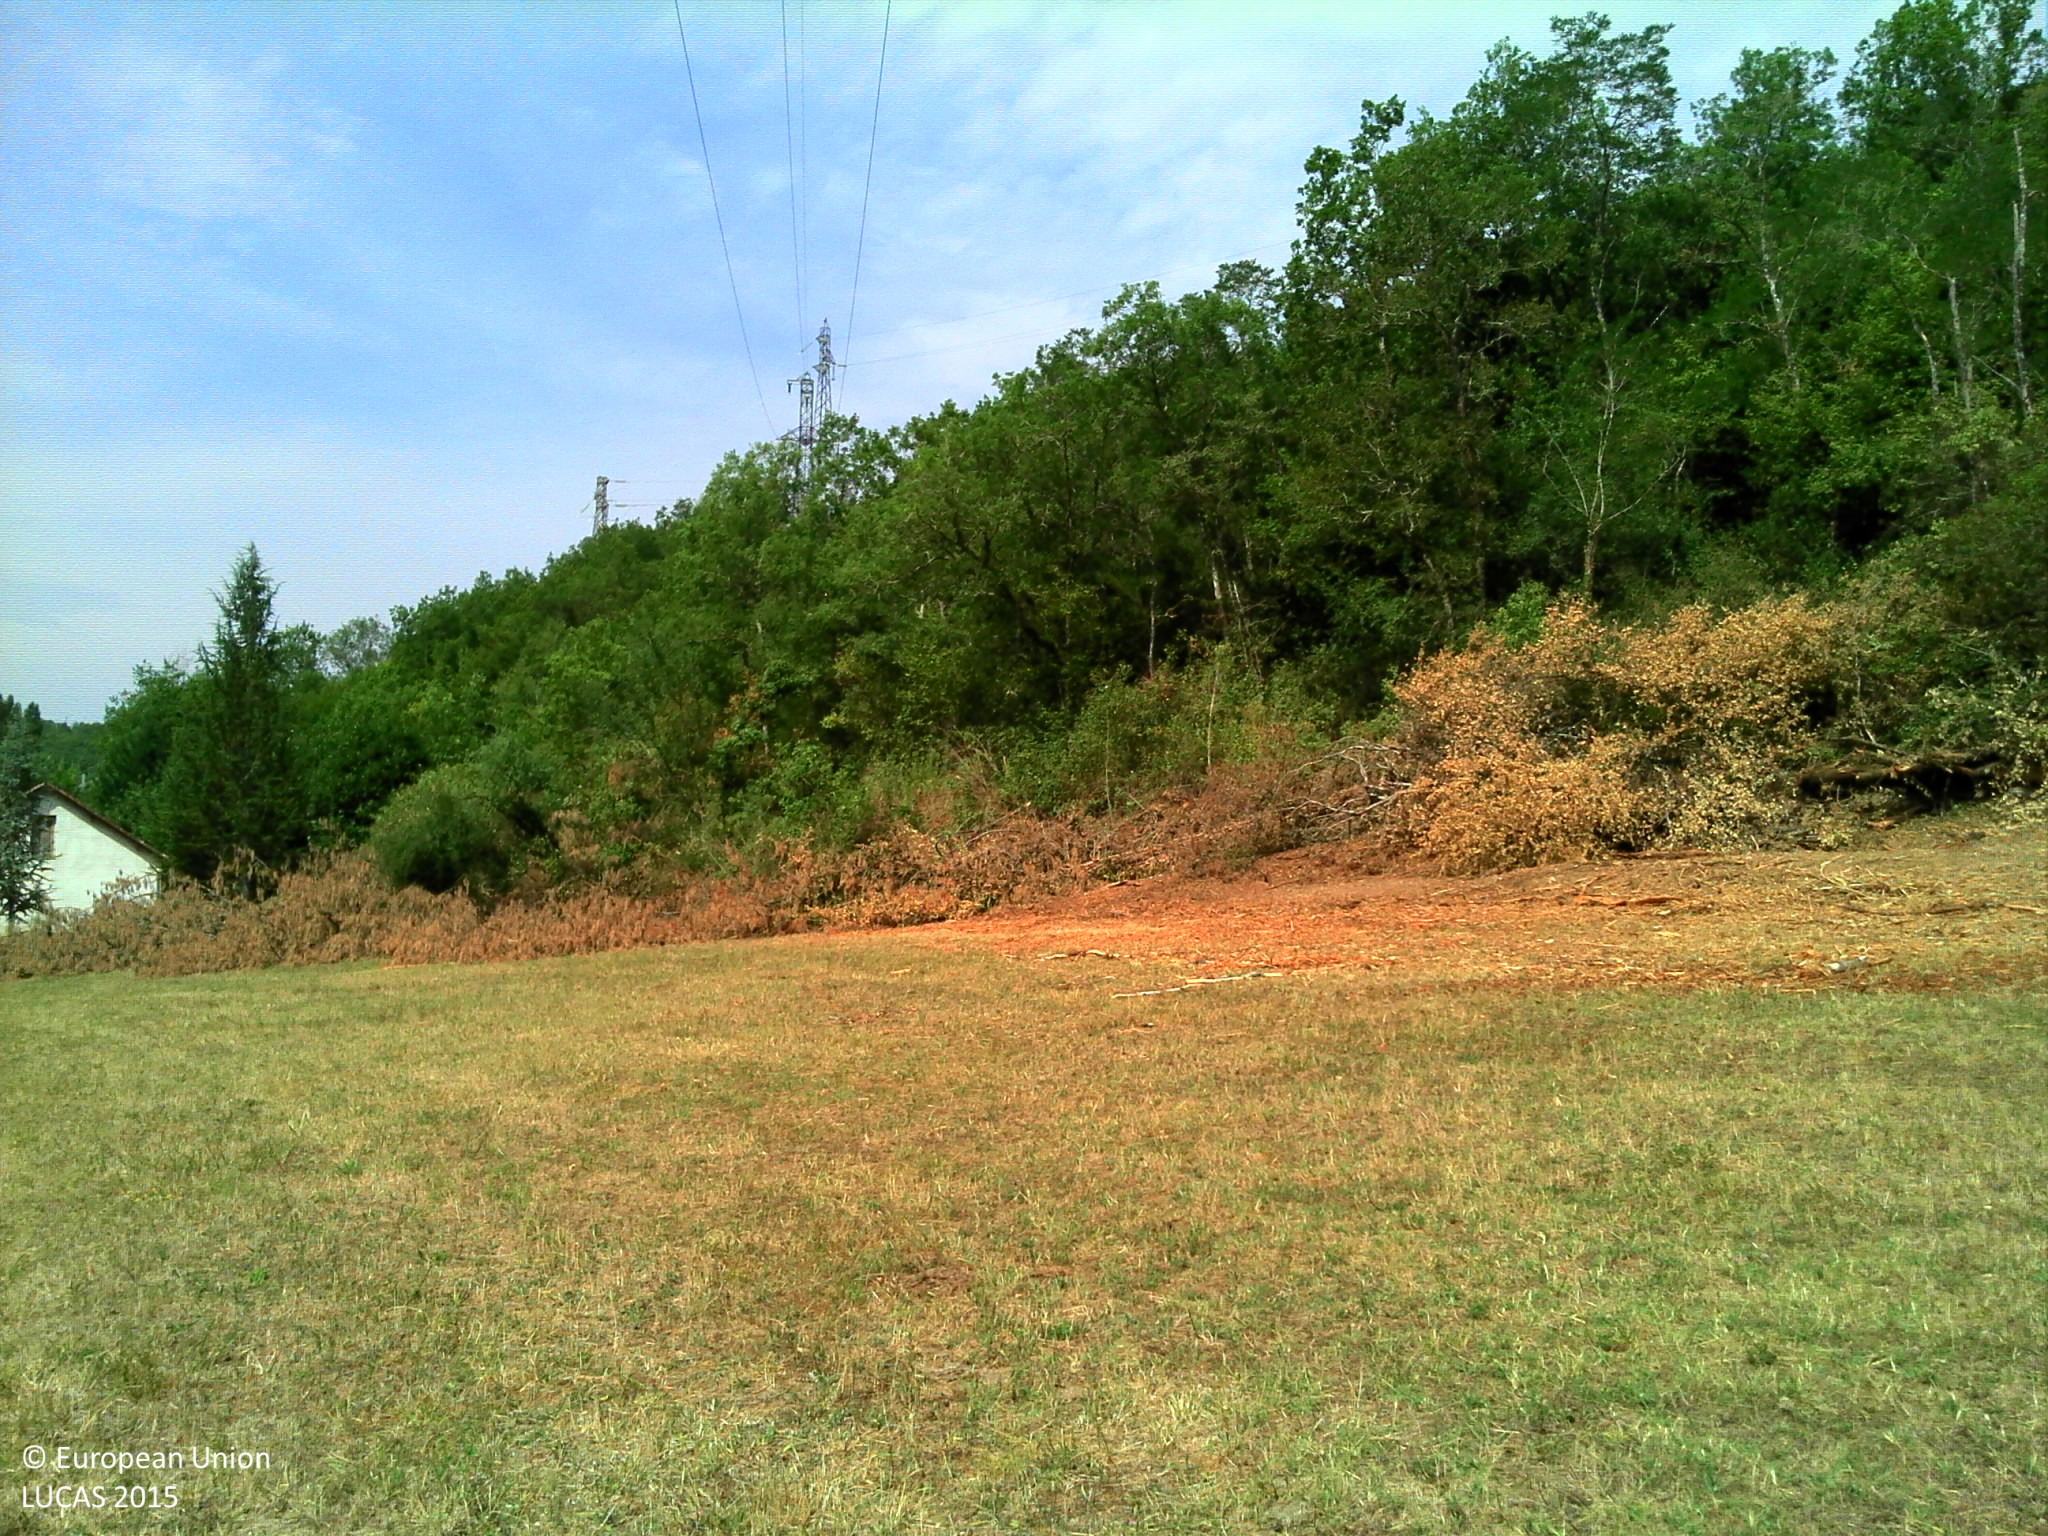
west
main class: Grassland
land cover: Grassland without tree/shrub cover
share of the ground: > 75 %
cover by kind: herbaceous plants 95 %, lichens and mosses 5 %
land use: Agriculture (excluding fallow land and kitchen gardens)
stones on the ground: < 10 %
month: July
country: FR
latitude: 45.0633
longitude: 1.1928
